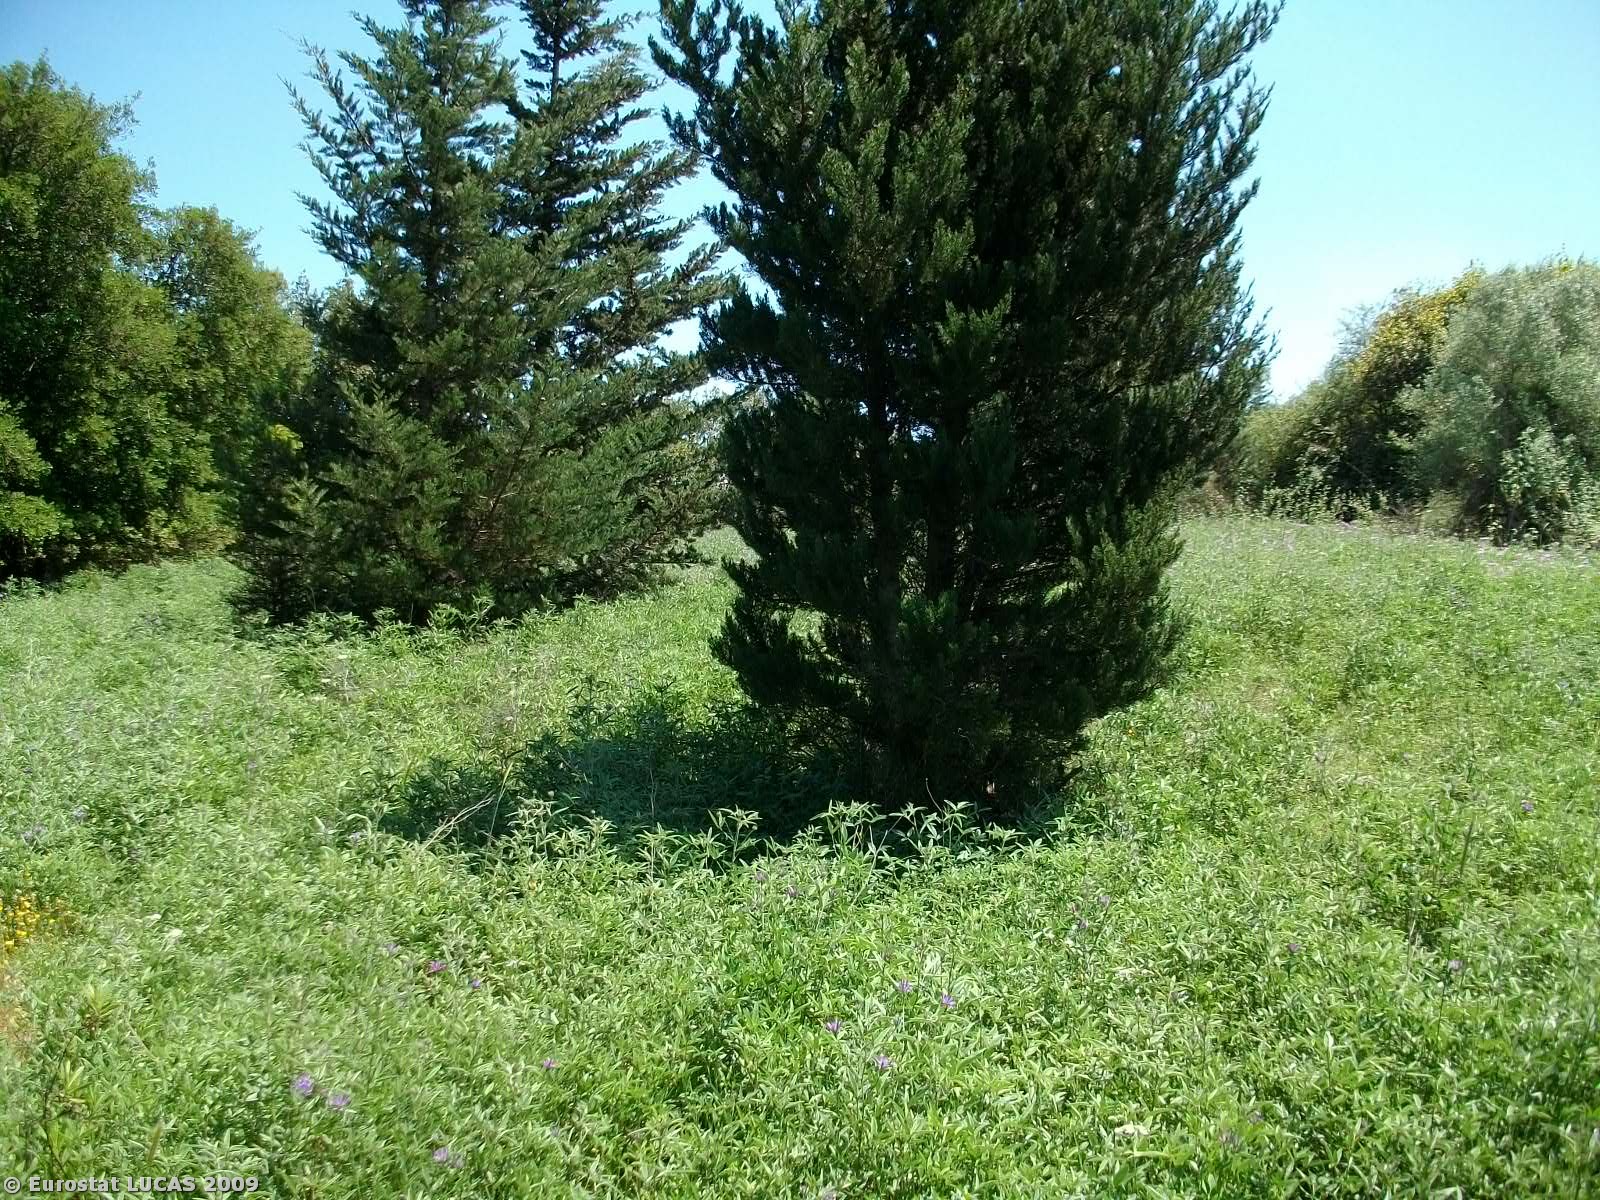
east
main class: Woodland
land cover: Mixed woodland
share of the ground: 25 - 50 %
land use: Forestry
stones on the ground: < 10 %
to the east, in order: Mixed woodland; Paved roads, cycling and walking lanes; Lines of trees; Fences; Grassland with sparse tree/shrub cover; Olive groves; Electric lines; Paved roads, cycling and walking lanes; Fences; Grassland with sparse tree/shrub cover; Olive groves
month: May
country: GR
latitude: 35.3673
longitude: 24.2159
